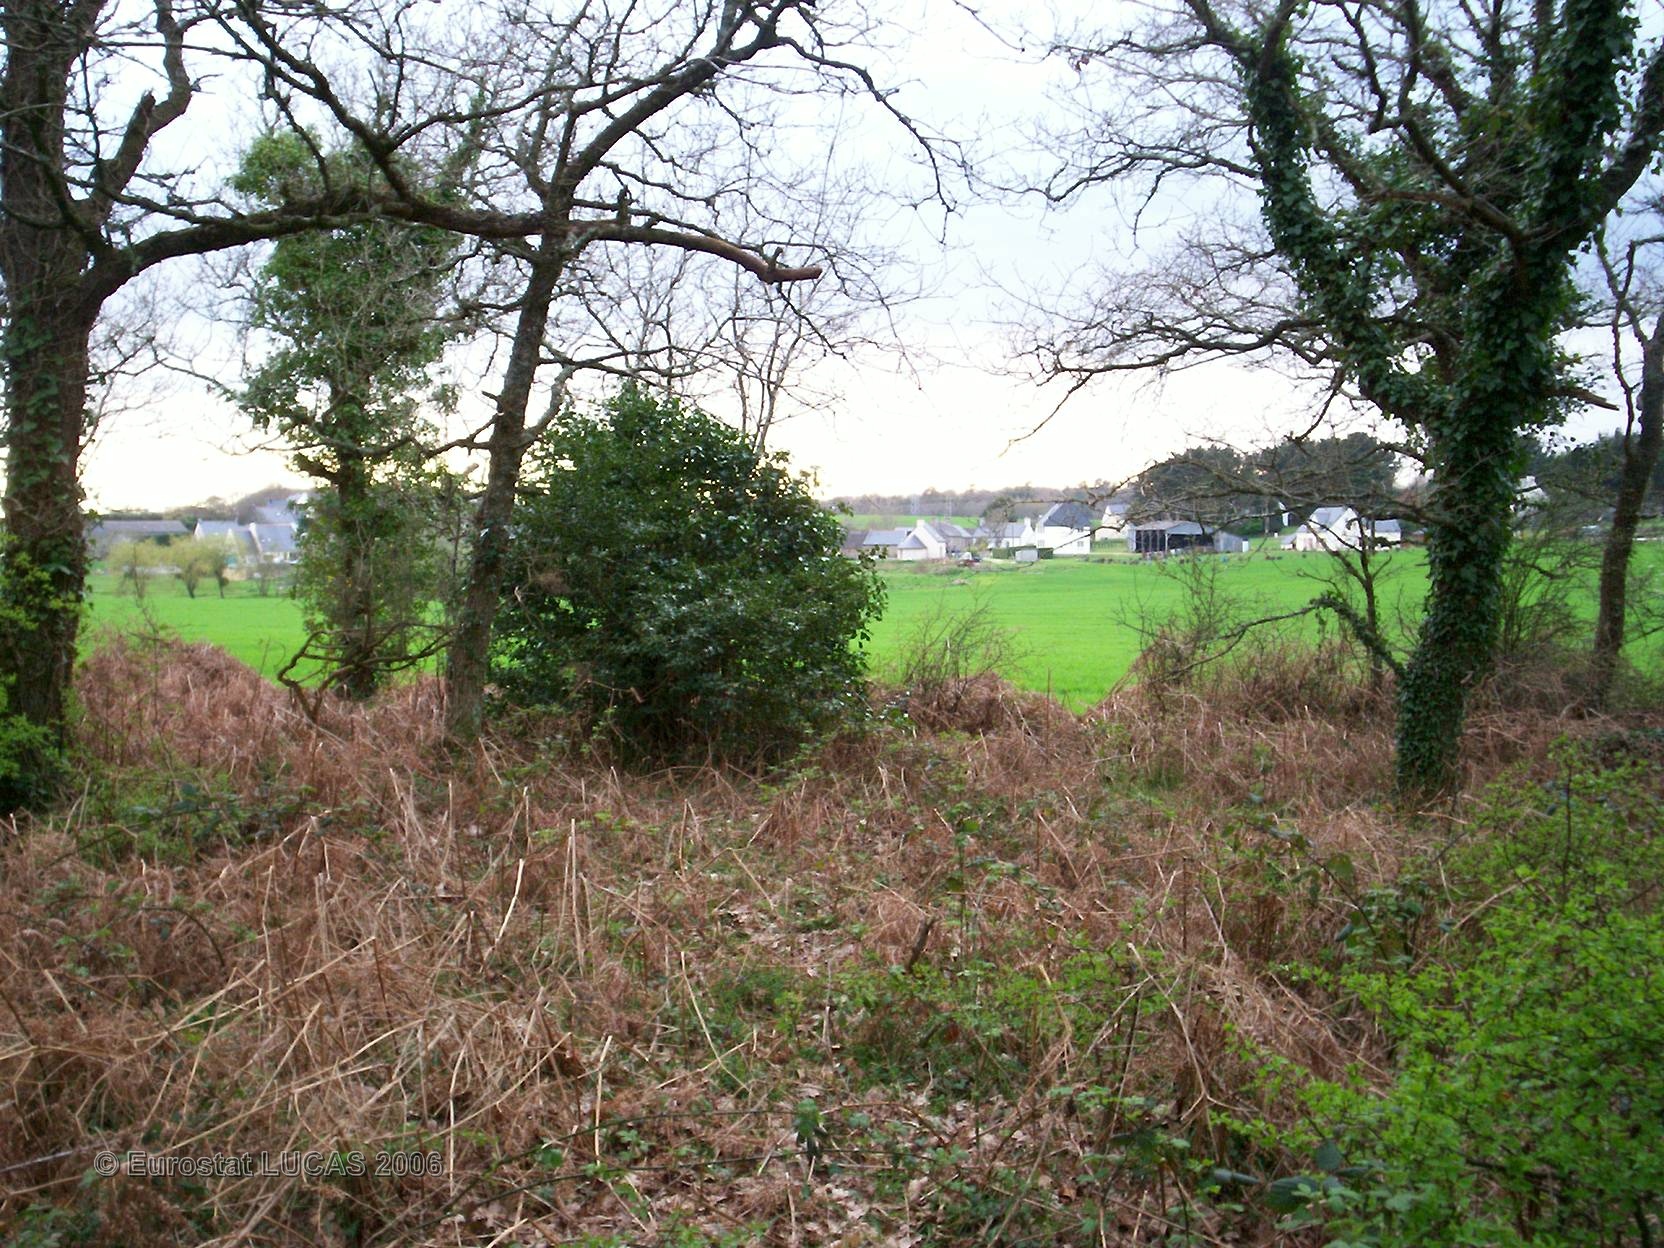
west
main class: Woodland
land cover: Broadleaved forest
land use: Forestry
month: April
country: FR
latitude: 47.7942
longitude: -3.4646
